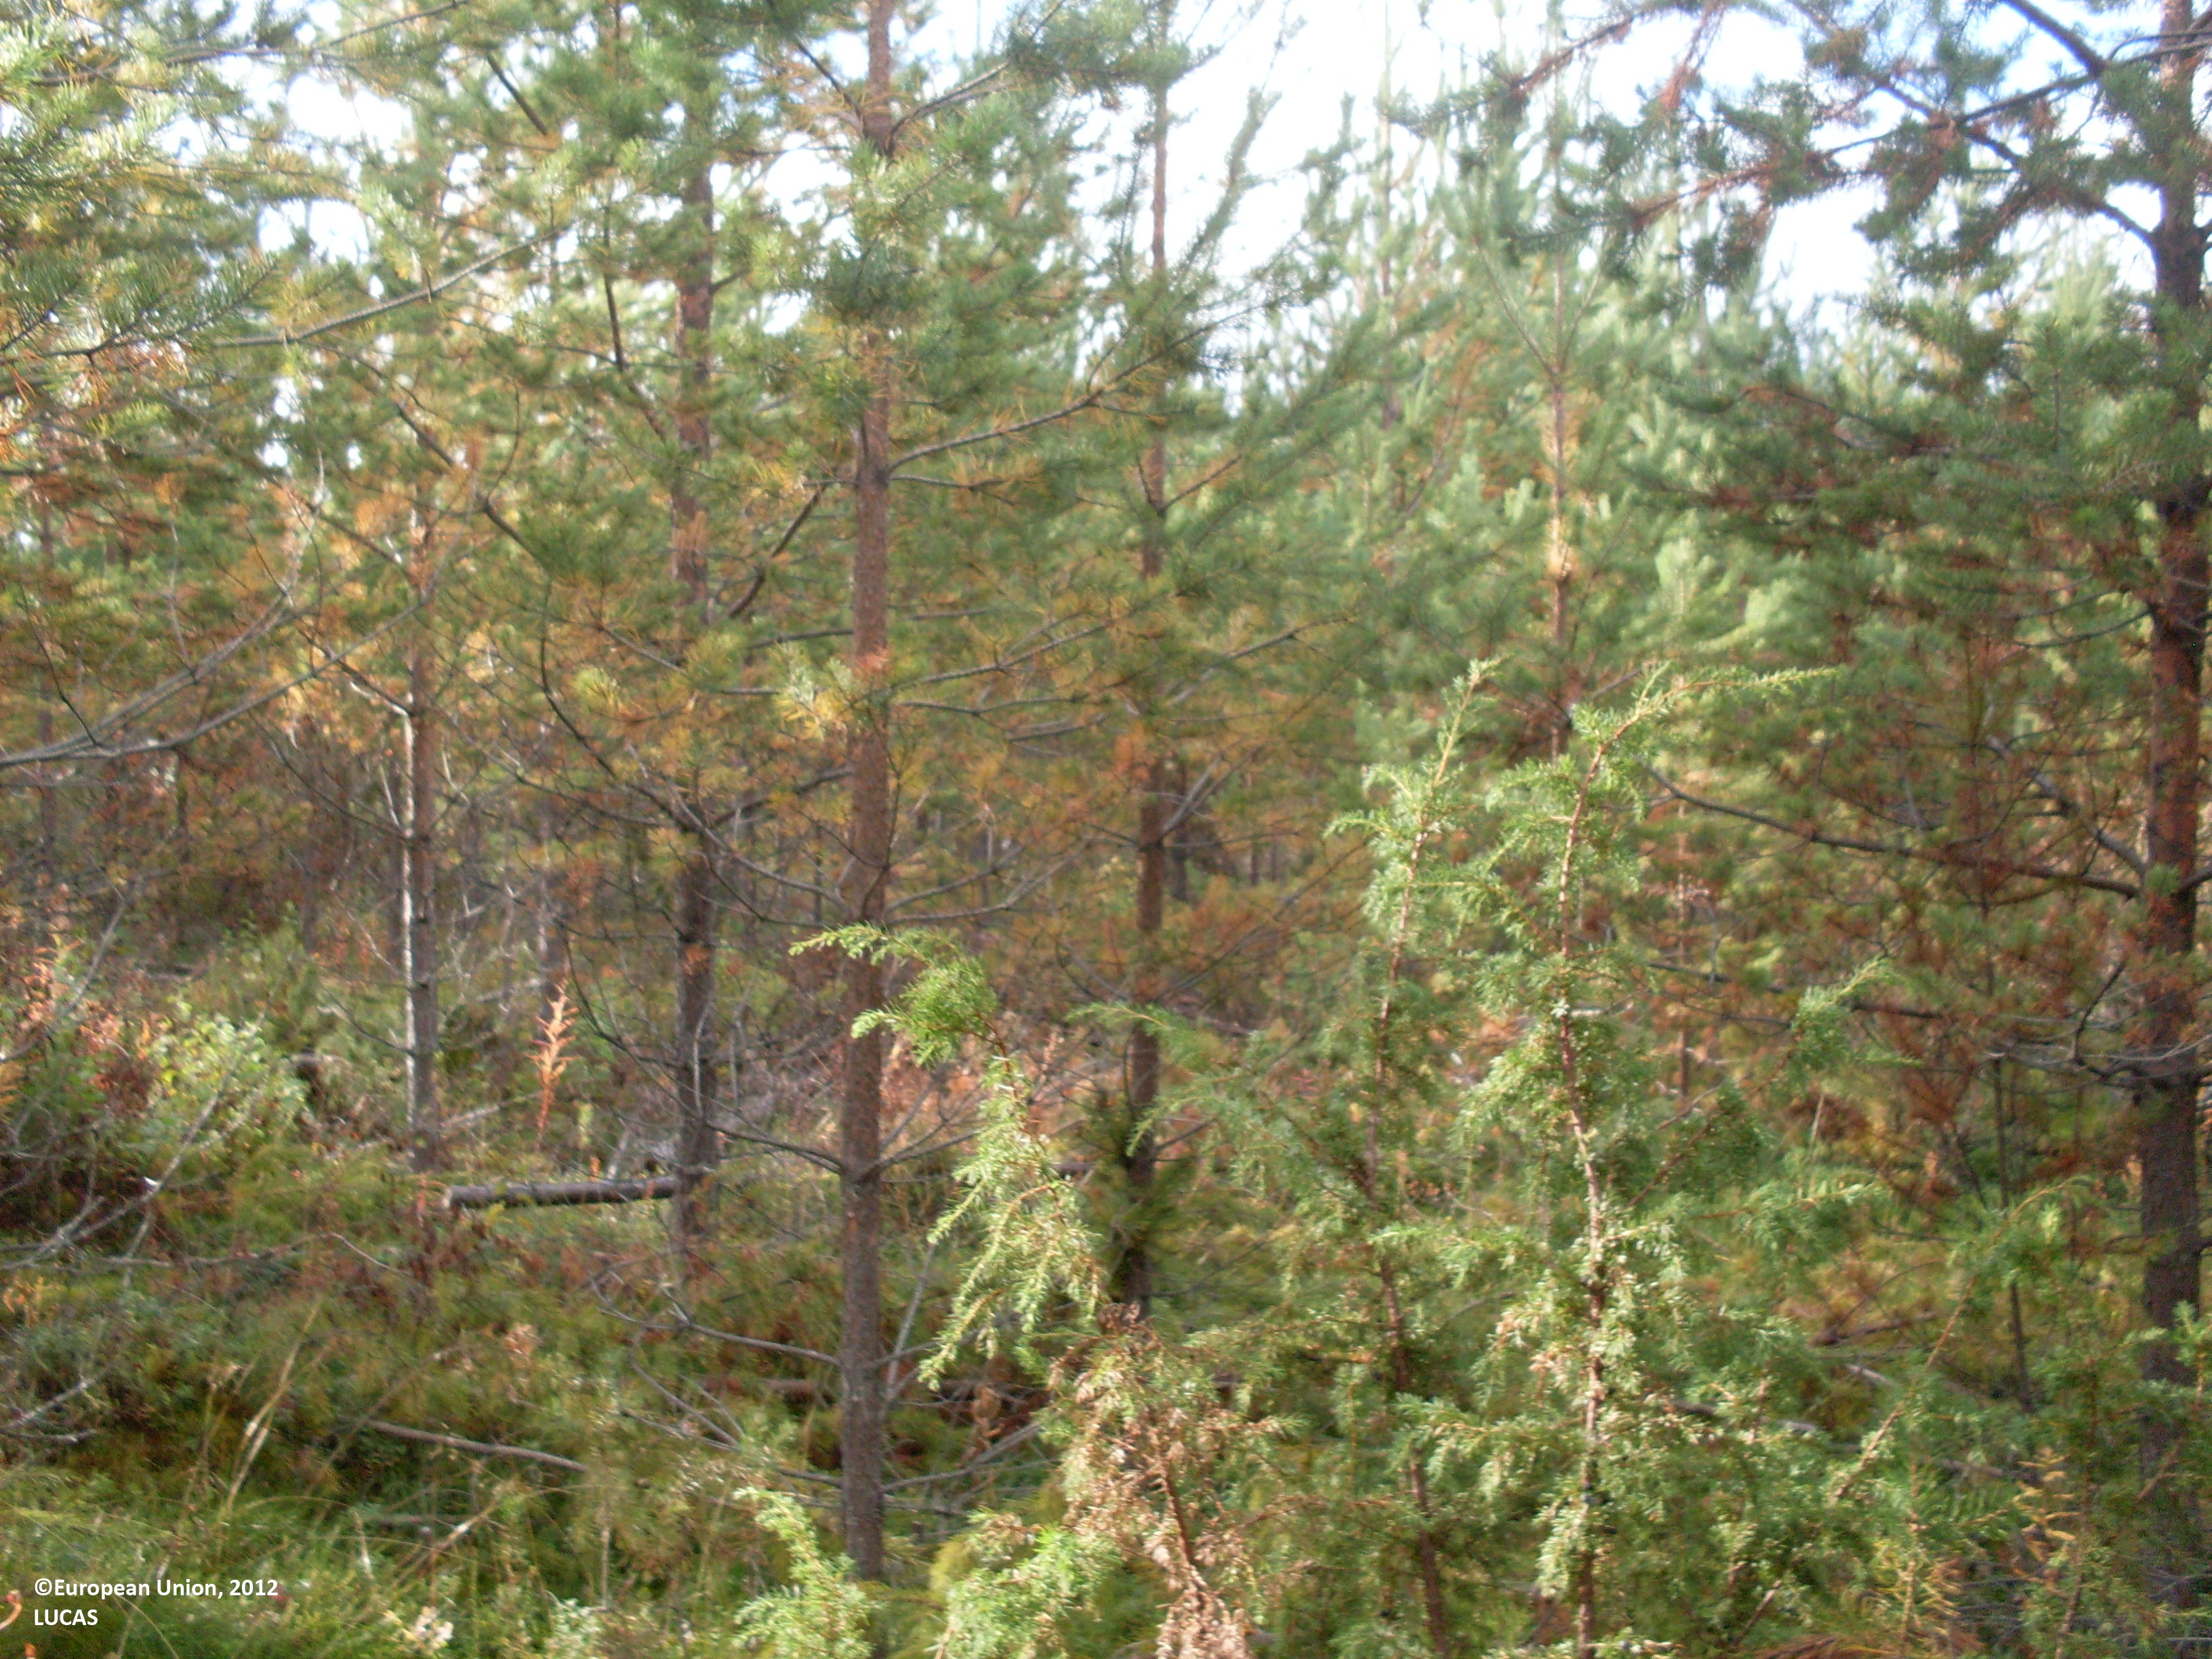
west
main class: Woodland
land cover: Pine dominated coniferous woodland
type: boreal forest
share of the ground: > 75 %
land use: Forestry
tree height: > 5 m
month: September
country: FI
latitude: 64.1234
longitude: 28.4358
